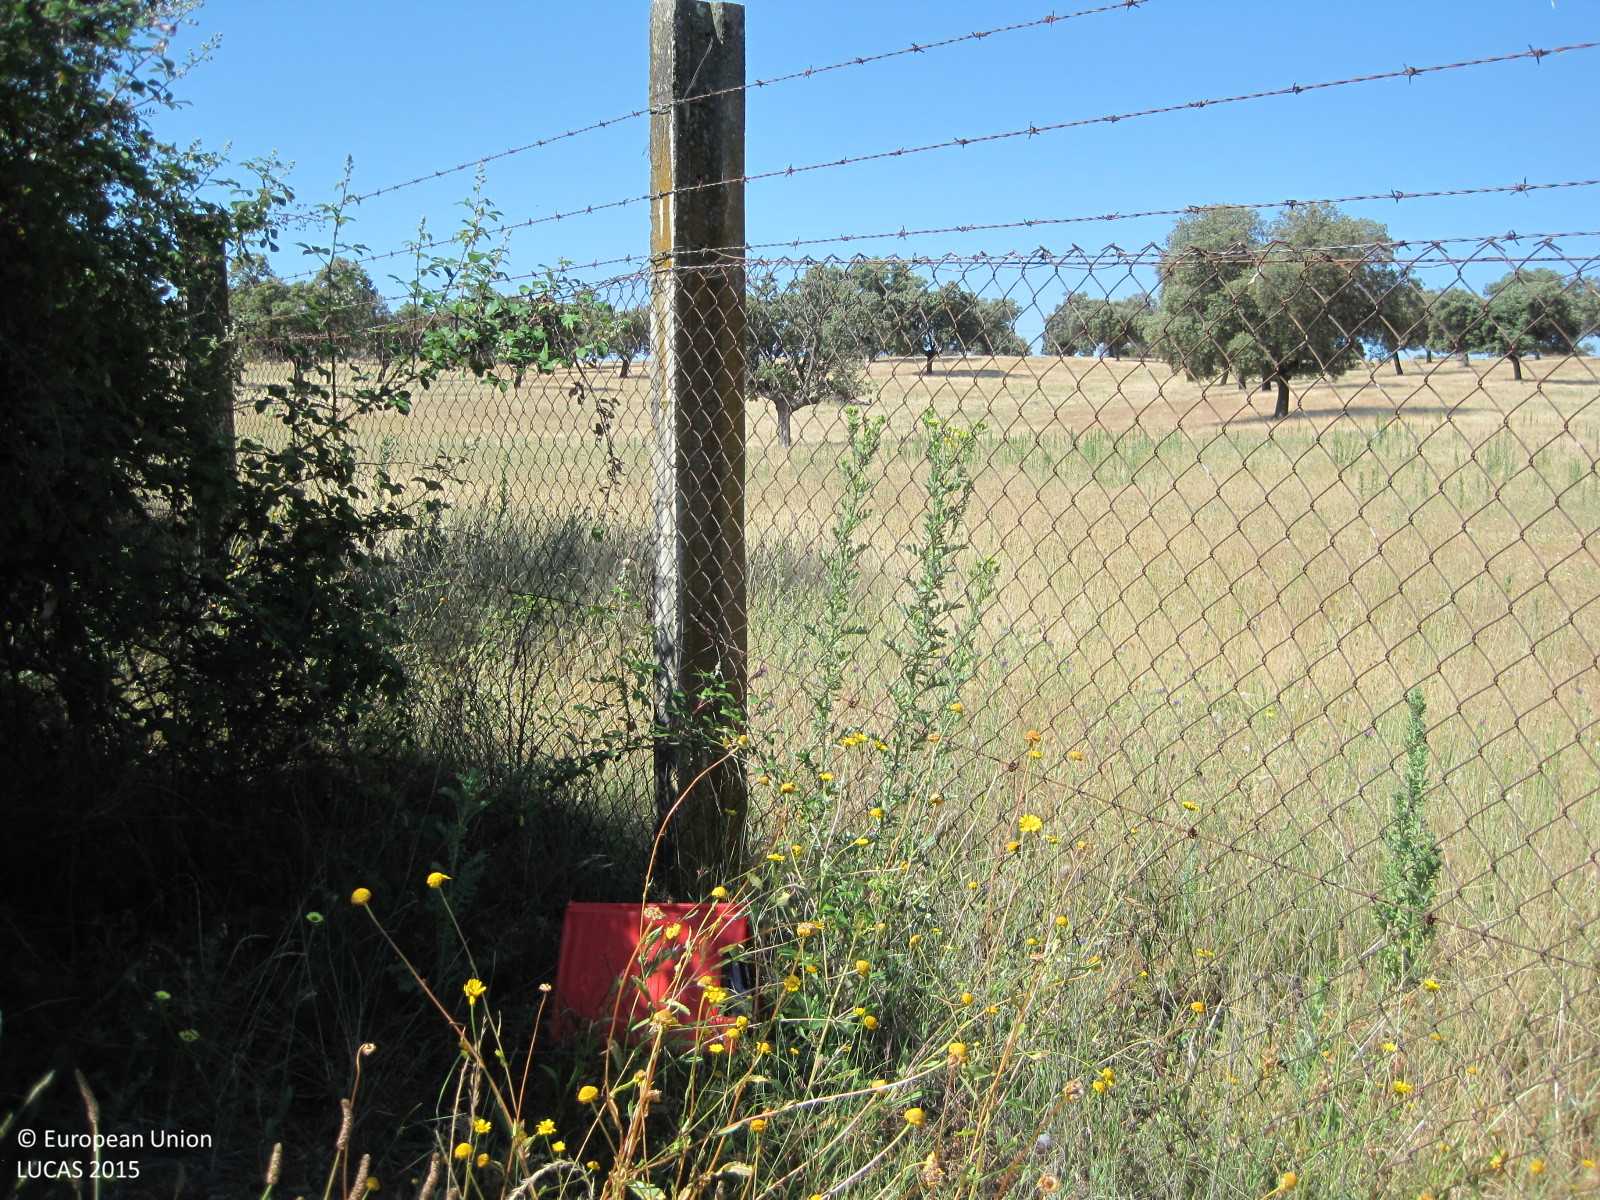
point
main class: Grassland
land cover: Grassland without tree/shrub cover
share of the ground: > 75 %
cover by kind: herbaceous plants 100 %
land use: Agriculture (excluding fallow land and kitchen gardens)
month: May
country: ES
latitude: 40.2211
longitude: -4.7989
